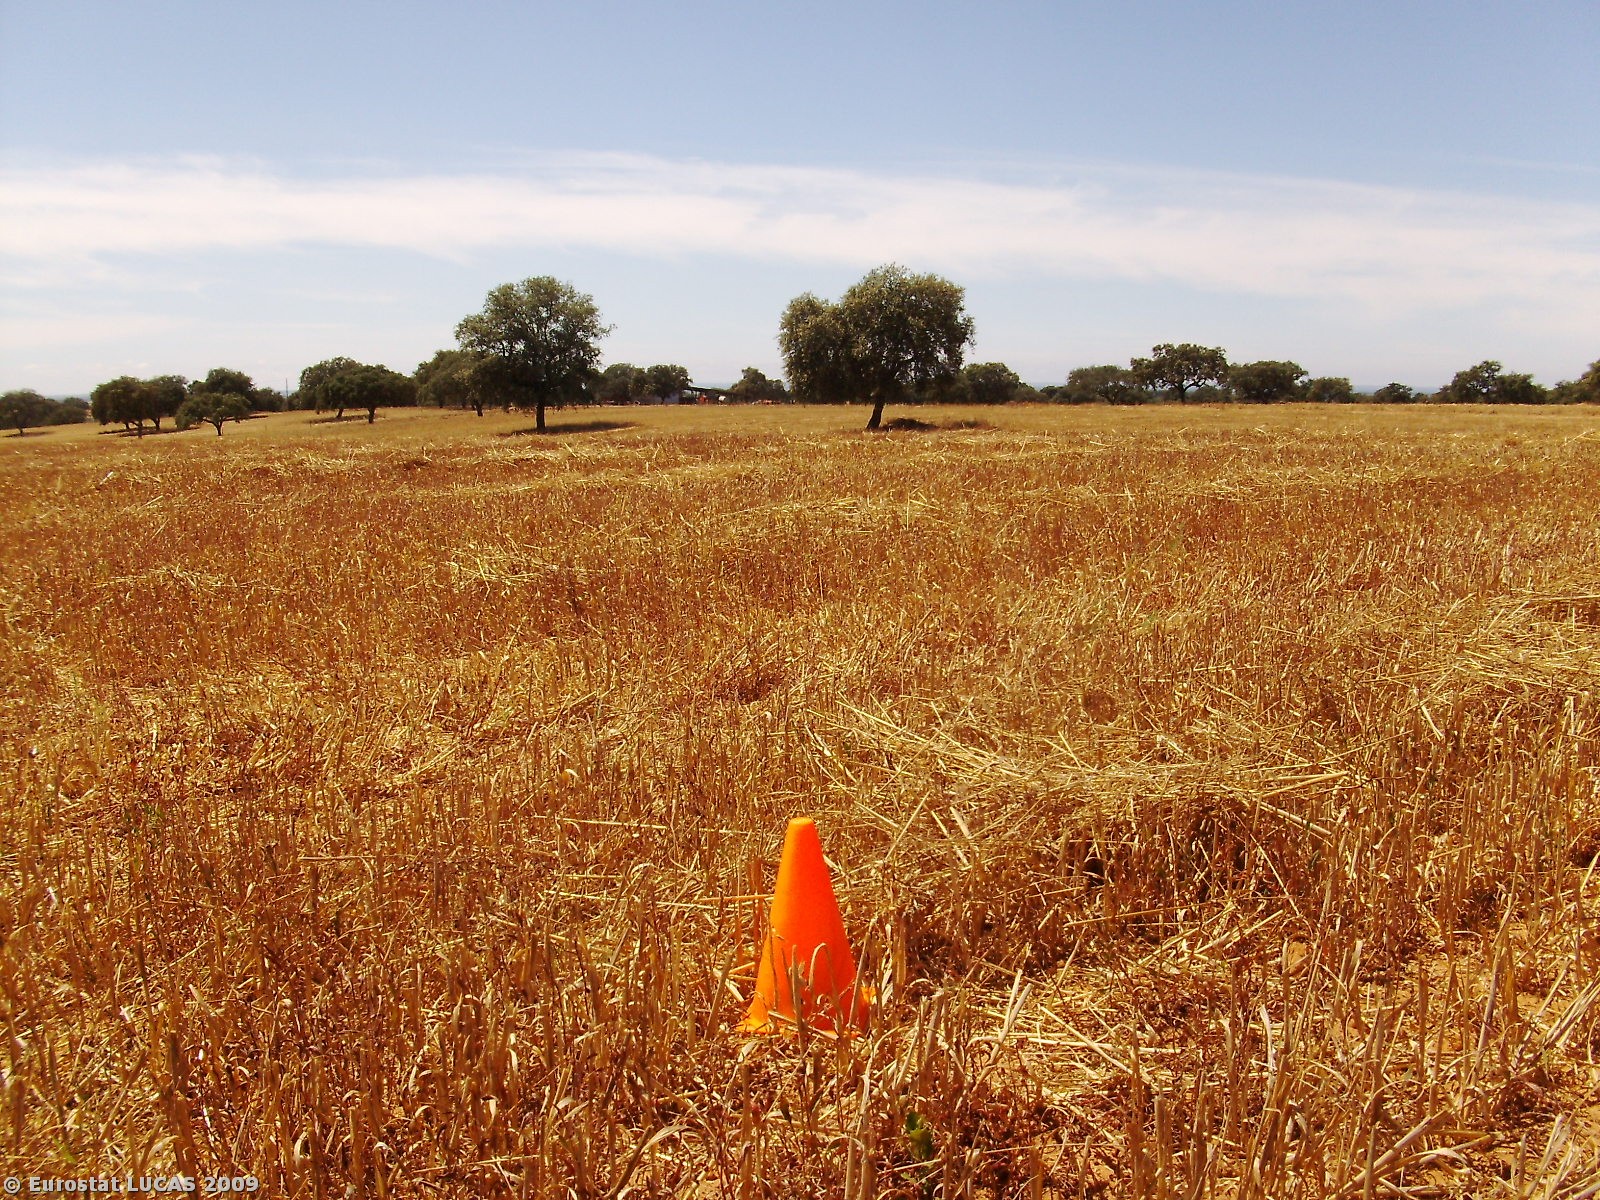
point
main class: Cropland
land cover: Oats
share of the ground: > 75 %
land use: Agriculture (excluding fallow land and kitchen gardens)
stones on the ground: 10 - 25 %
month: July
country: PT
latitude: 37.8410
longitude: -8.3189
